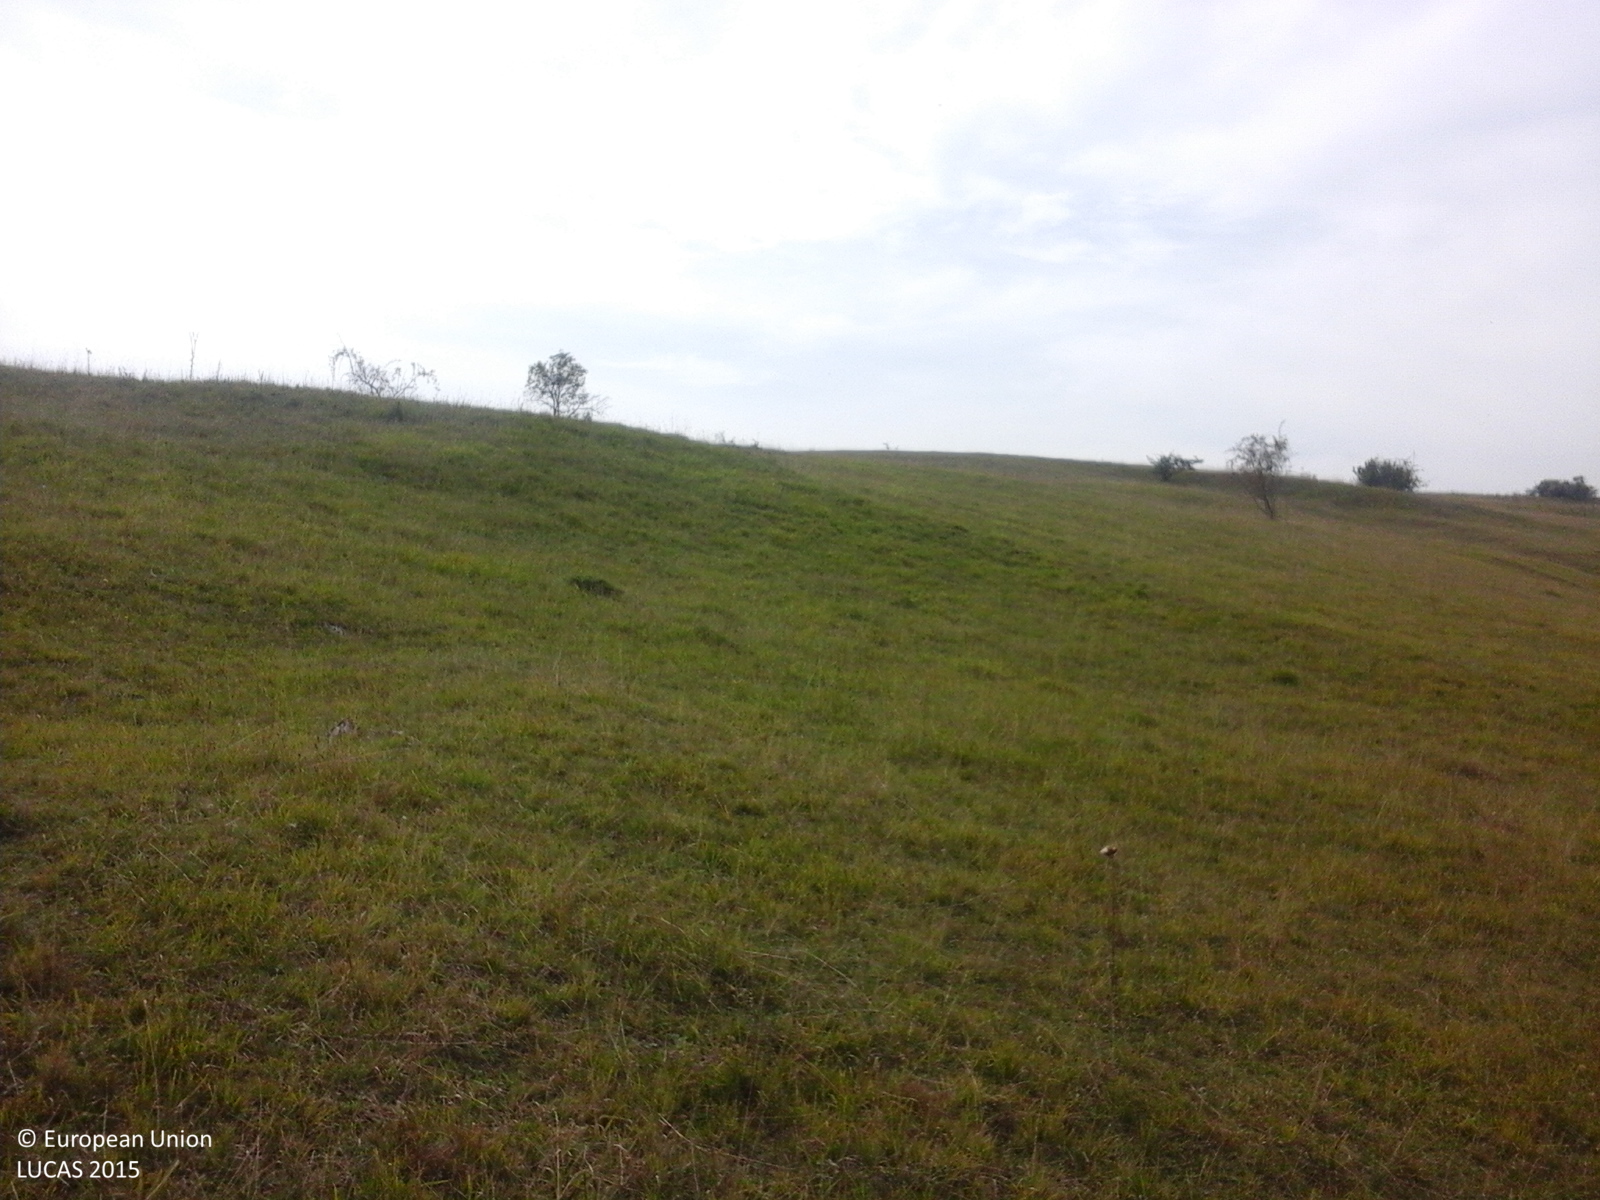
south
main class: Grassland
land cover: Grassland without tree/shrub cover
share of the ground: > 75 %
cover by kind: herbaceous plants 100 %
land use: Agriculture (excluding fallow land and kitchen gardens)
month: September
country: RO
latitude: 46.8882
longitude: 23.1218
